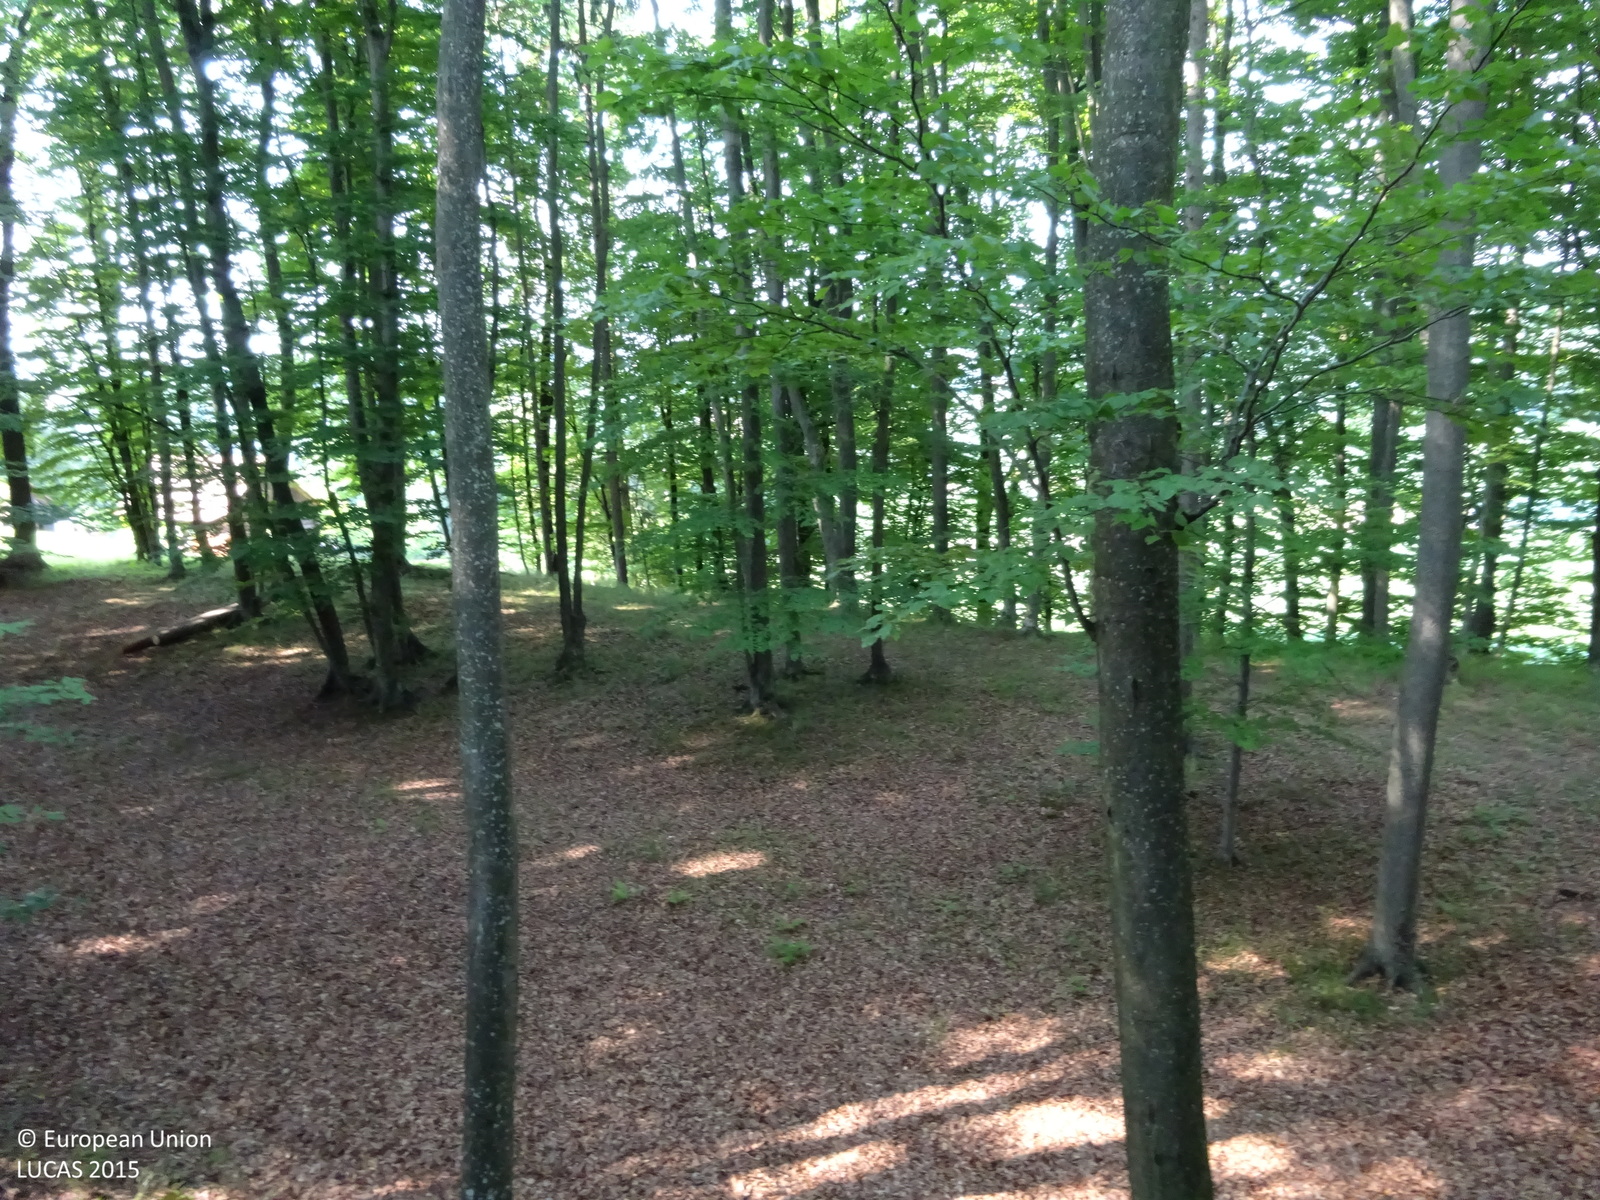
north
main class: Woodland
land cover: Broadleaved woodland
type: mountainous beech forest
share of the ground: > 75 %
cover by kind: broadleaved forest trees 100 %
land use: Forestry
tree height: > 5 m
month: July
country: AT
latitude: 46.8706
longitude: 15.9700
